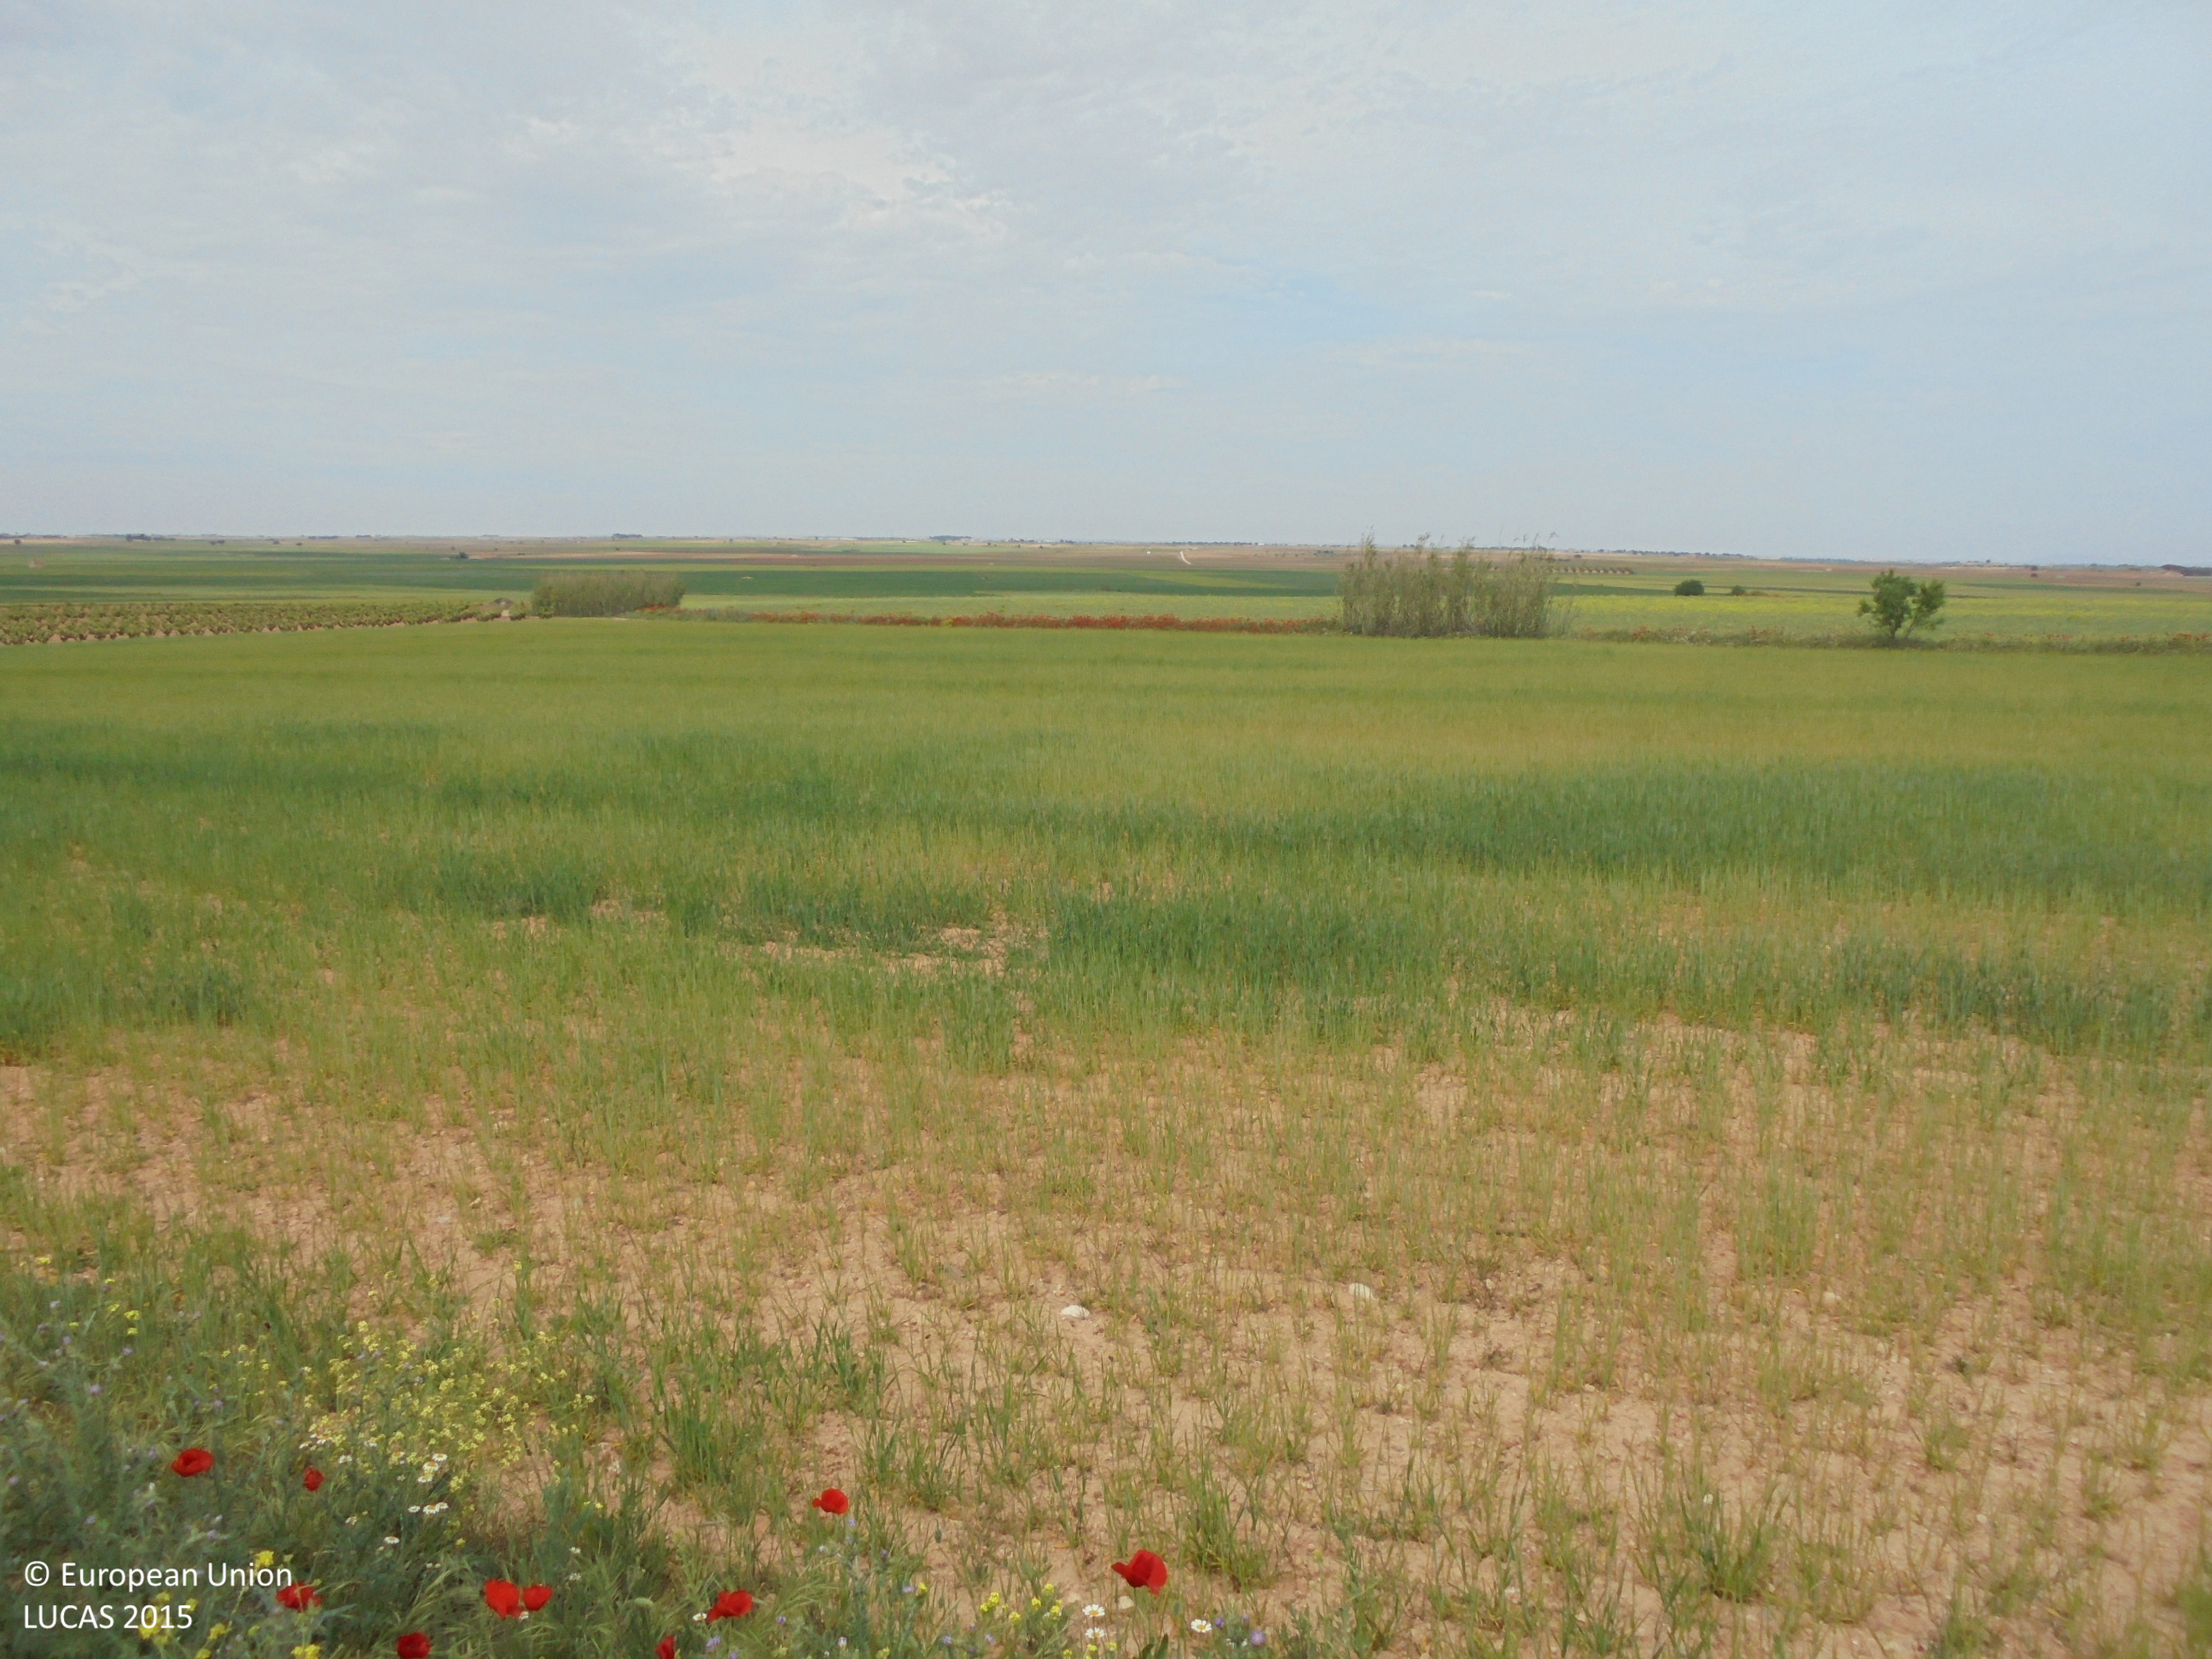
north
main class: Cropland
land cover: Barley
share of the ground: 25 - 50 %
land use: Agriculture (excluding fallow land and kitchen gardens)
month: May
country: ES
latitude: 39.2424
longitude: -1.6462
